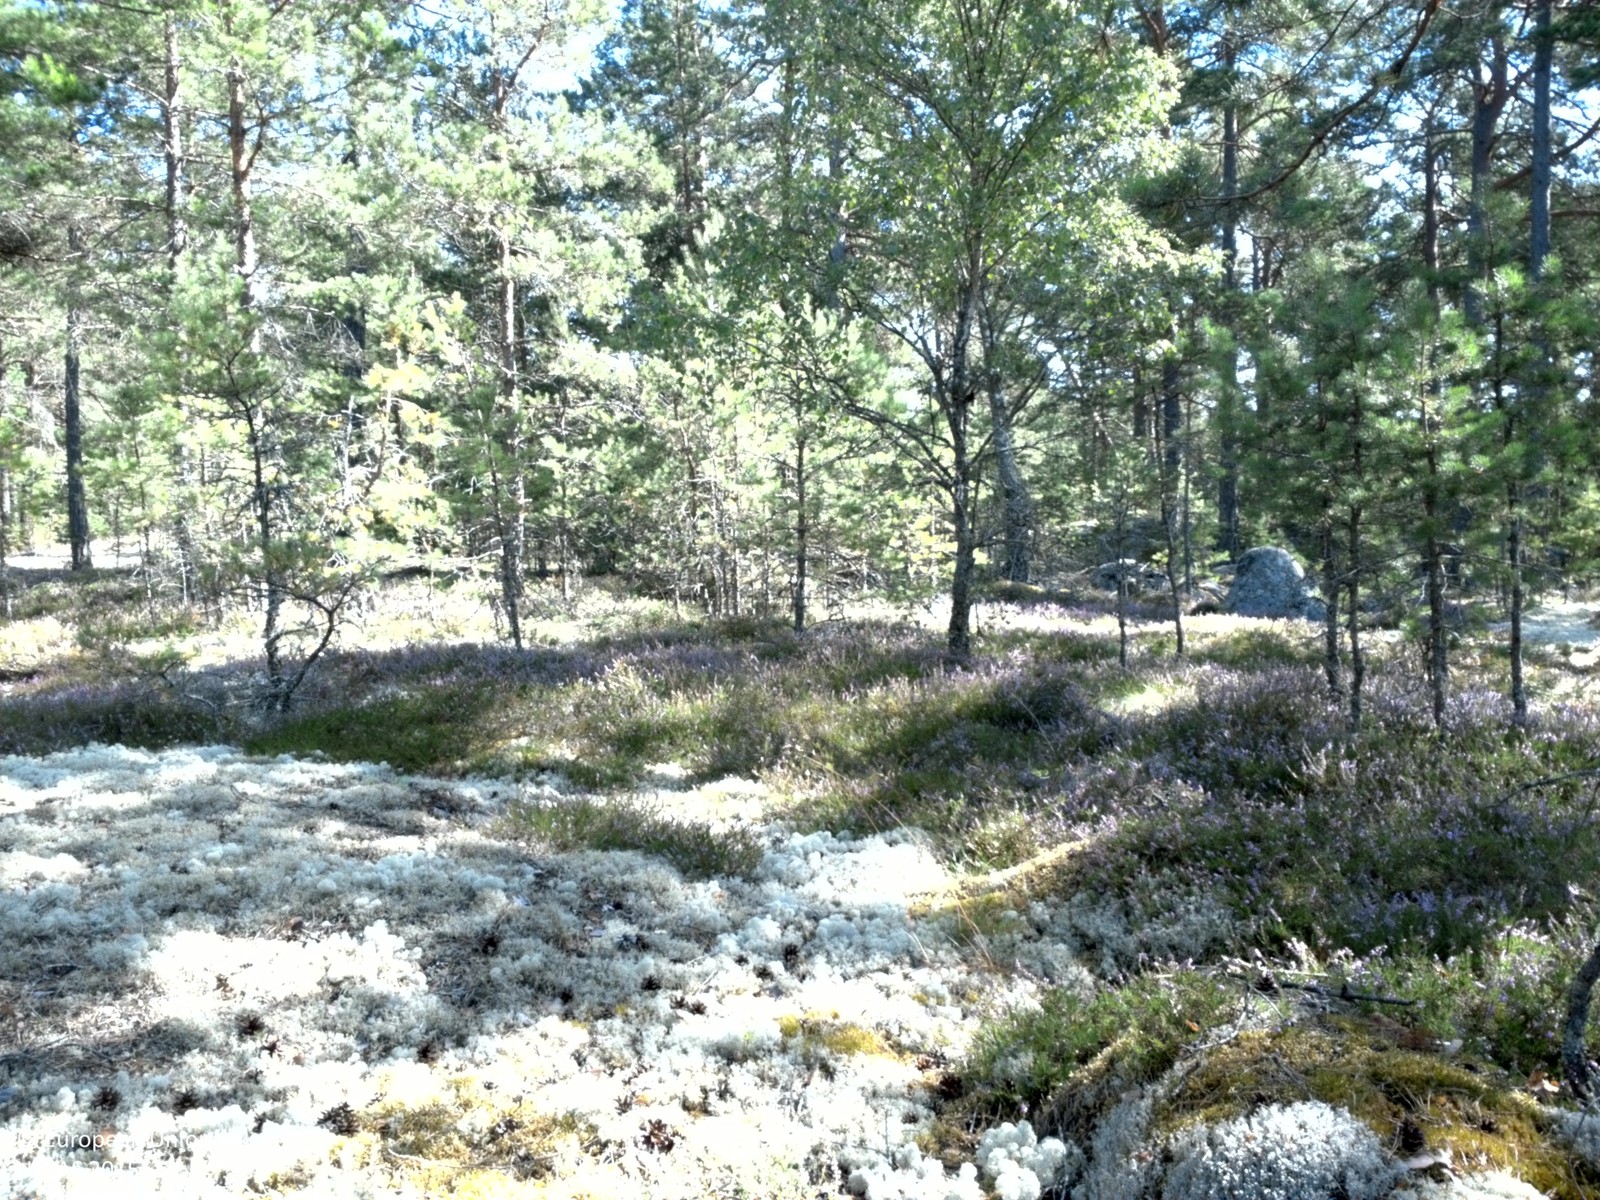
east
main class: Woodland
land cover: Pine dominated coniferous woodland
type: boreal forest
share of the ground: > 75 %
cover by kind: coniferous forest trees 60 %, lichens and mosses 25 %, shrubs 10 %, broadleaved forest trees 5 %
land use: Amenities, museums, leisure
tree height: > 5 m
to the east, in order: Pine dominated coniferous woodland
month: August
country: SE
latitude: 59.4452
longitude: 17.7033
